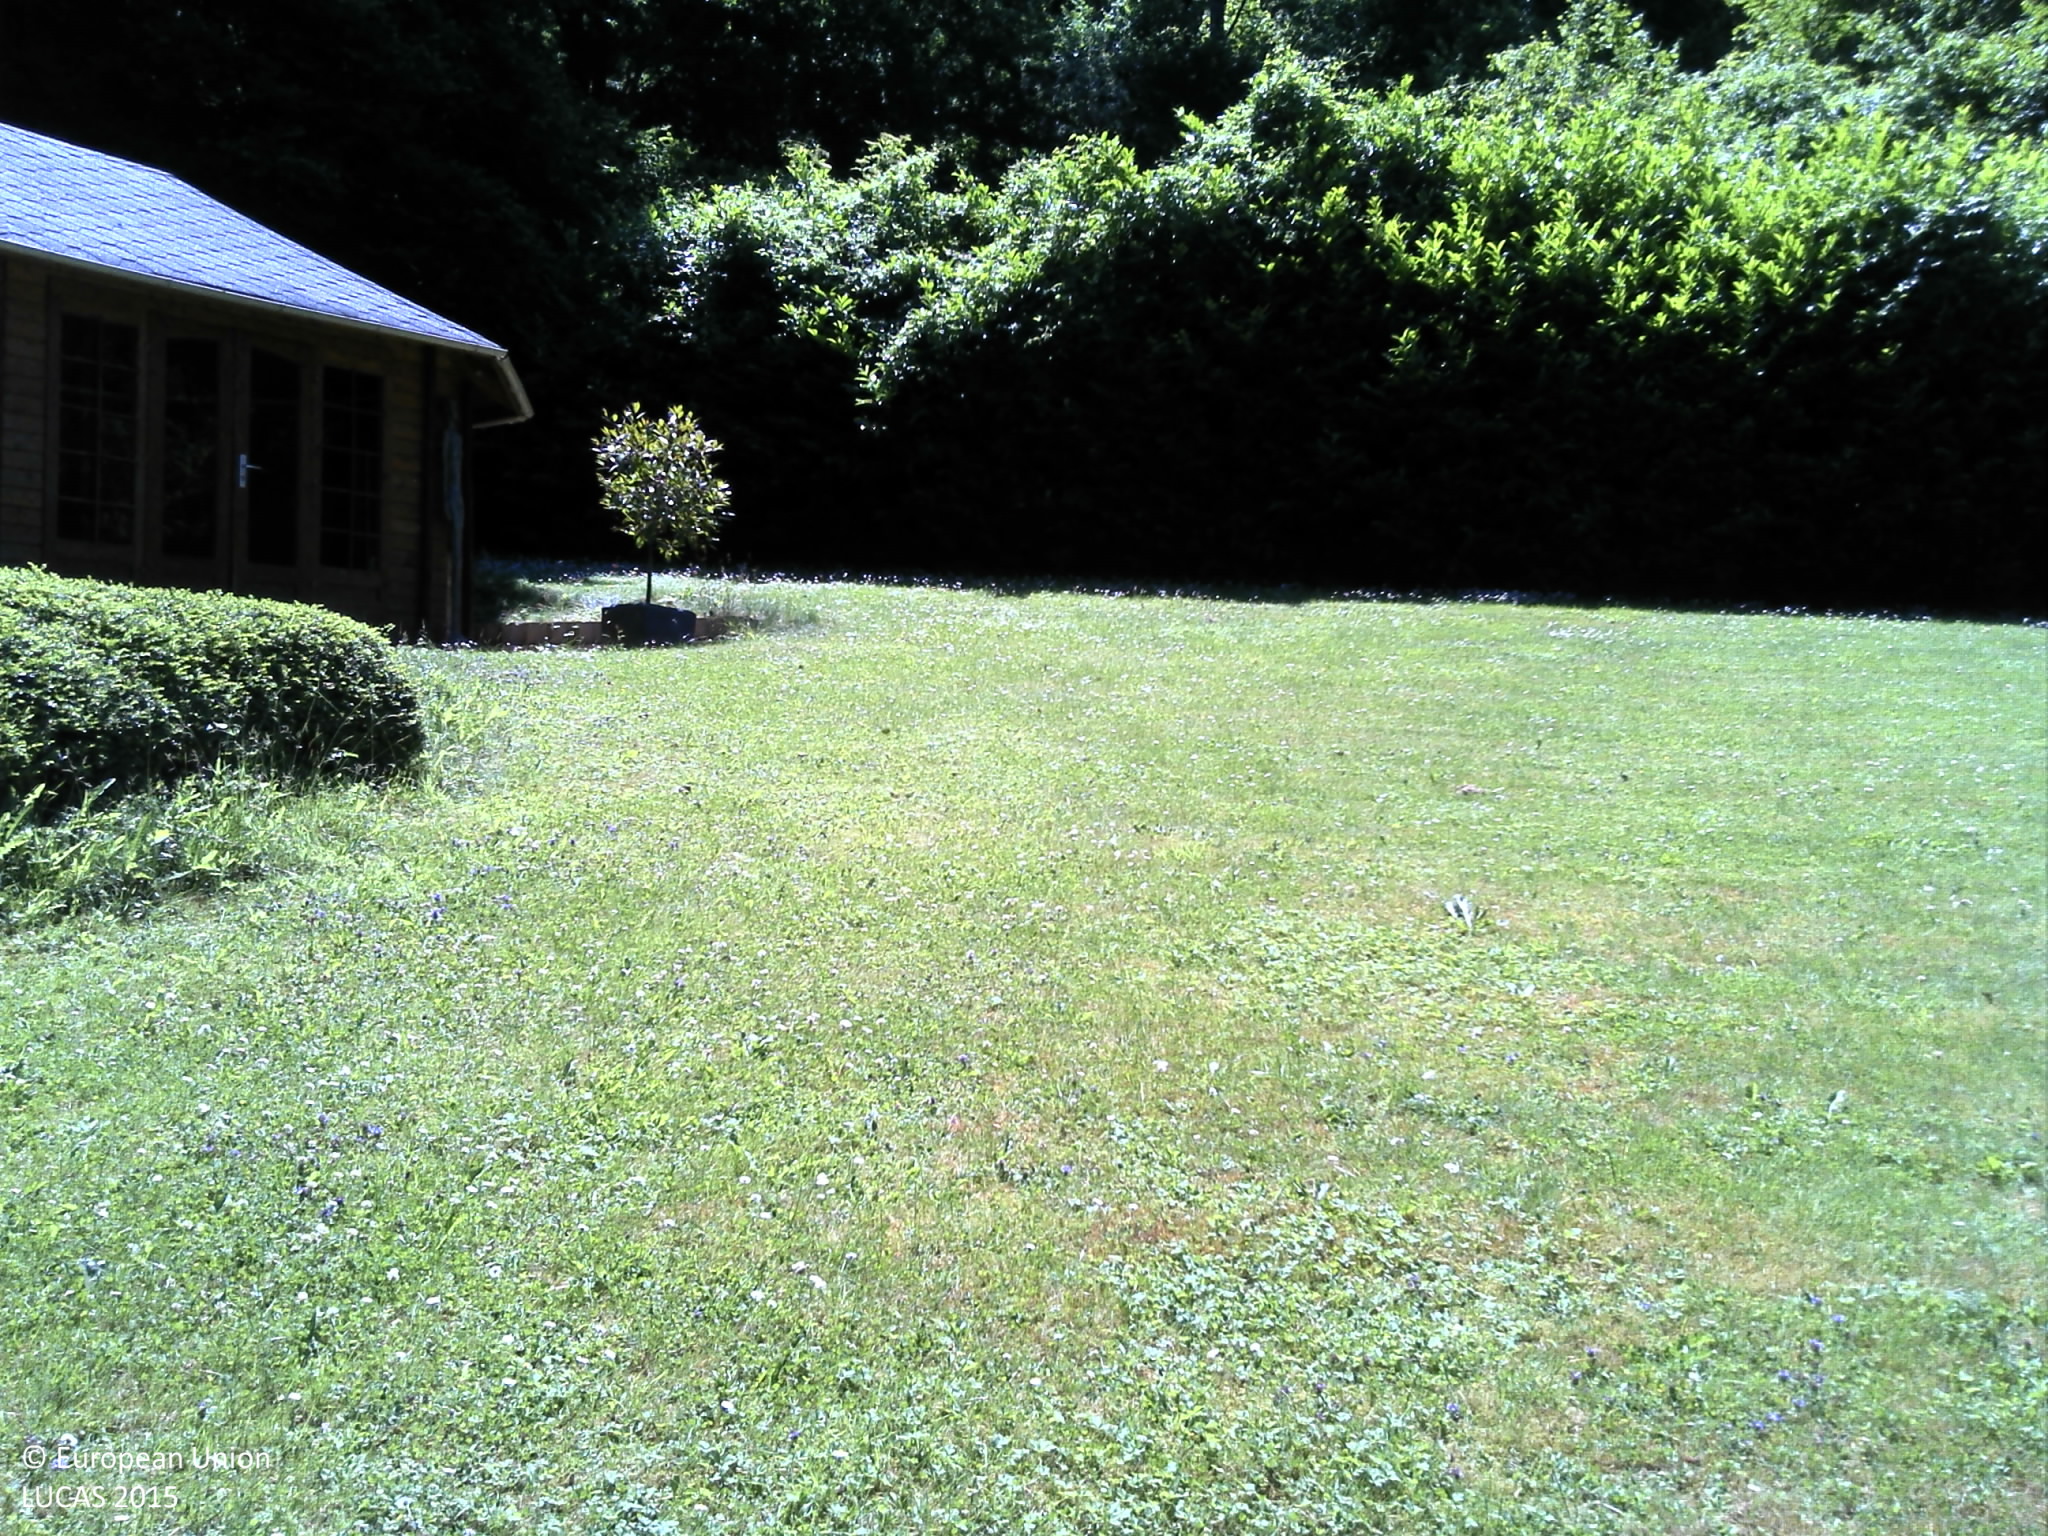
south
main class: Grassland
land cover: Grassland without tree/shrub cover
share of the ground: > 75 %
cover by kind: herbaceous plants 100 %
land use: Residential
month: June
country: FR
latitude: 49.3785
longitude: 6.0739
